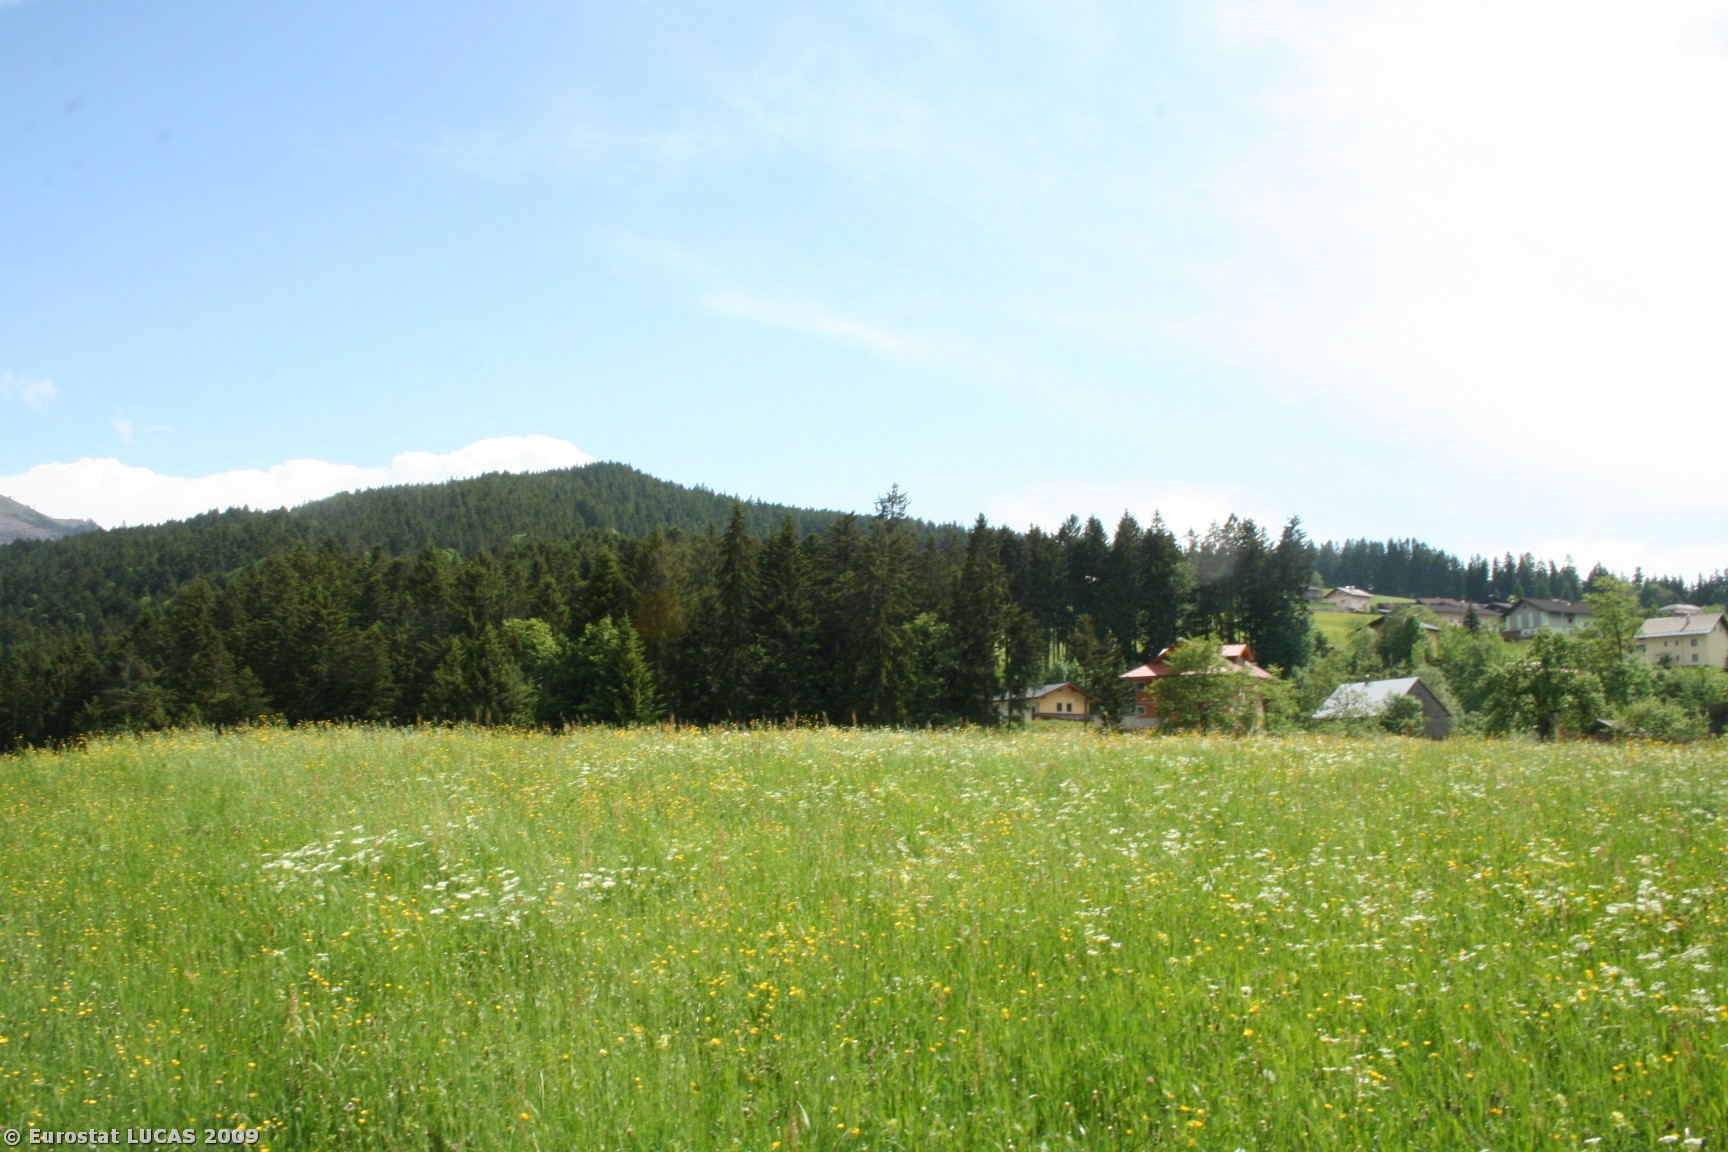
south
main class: Grassland
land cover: Grassland without tree/shrub cover
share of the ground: > 75 %
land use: Agriculture (excluding fallow land and kitchen gardens)
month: May
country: AT
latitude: 47.6366
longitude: 13.2061
